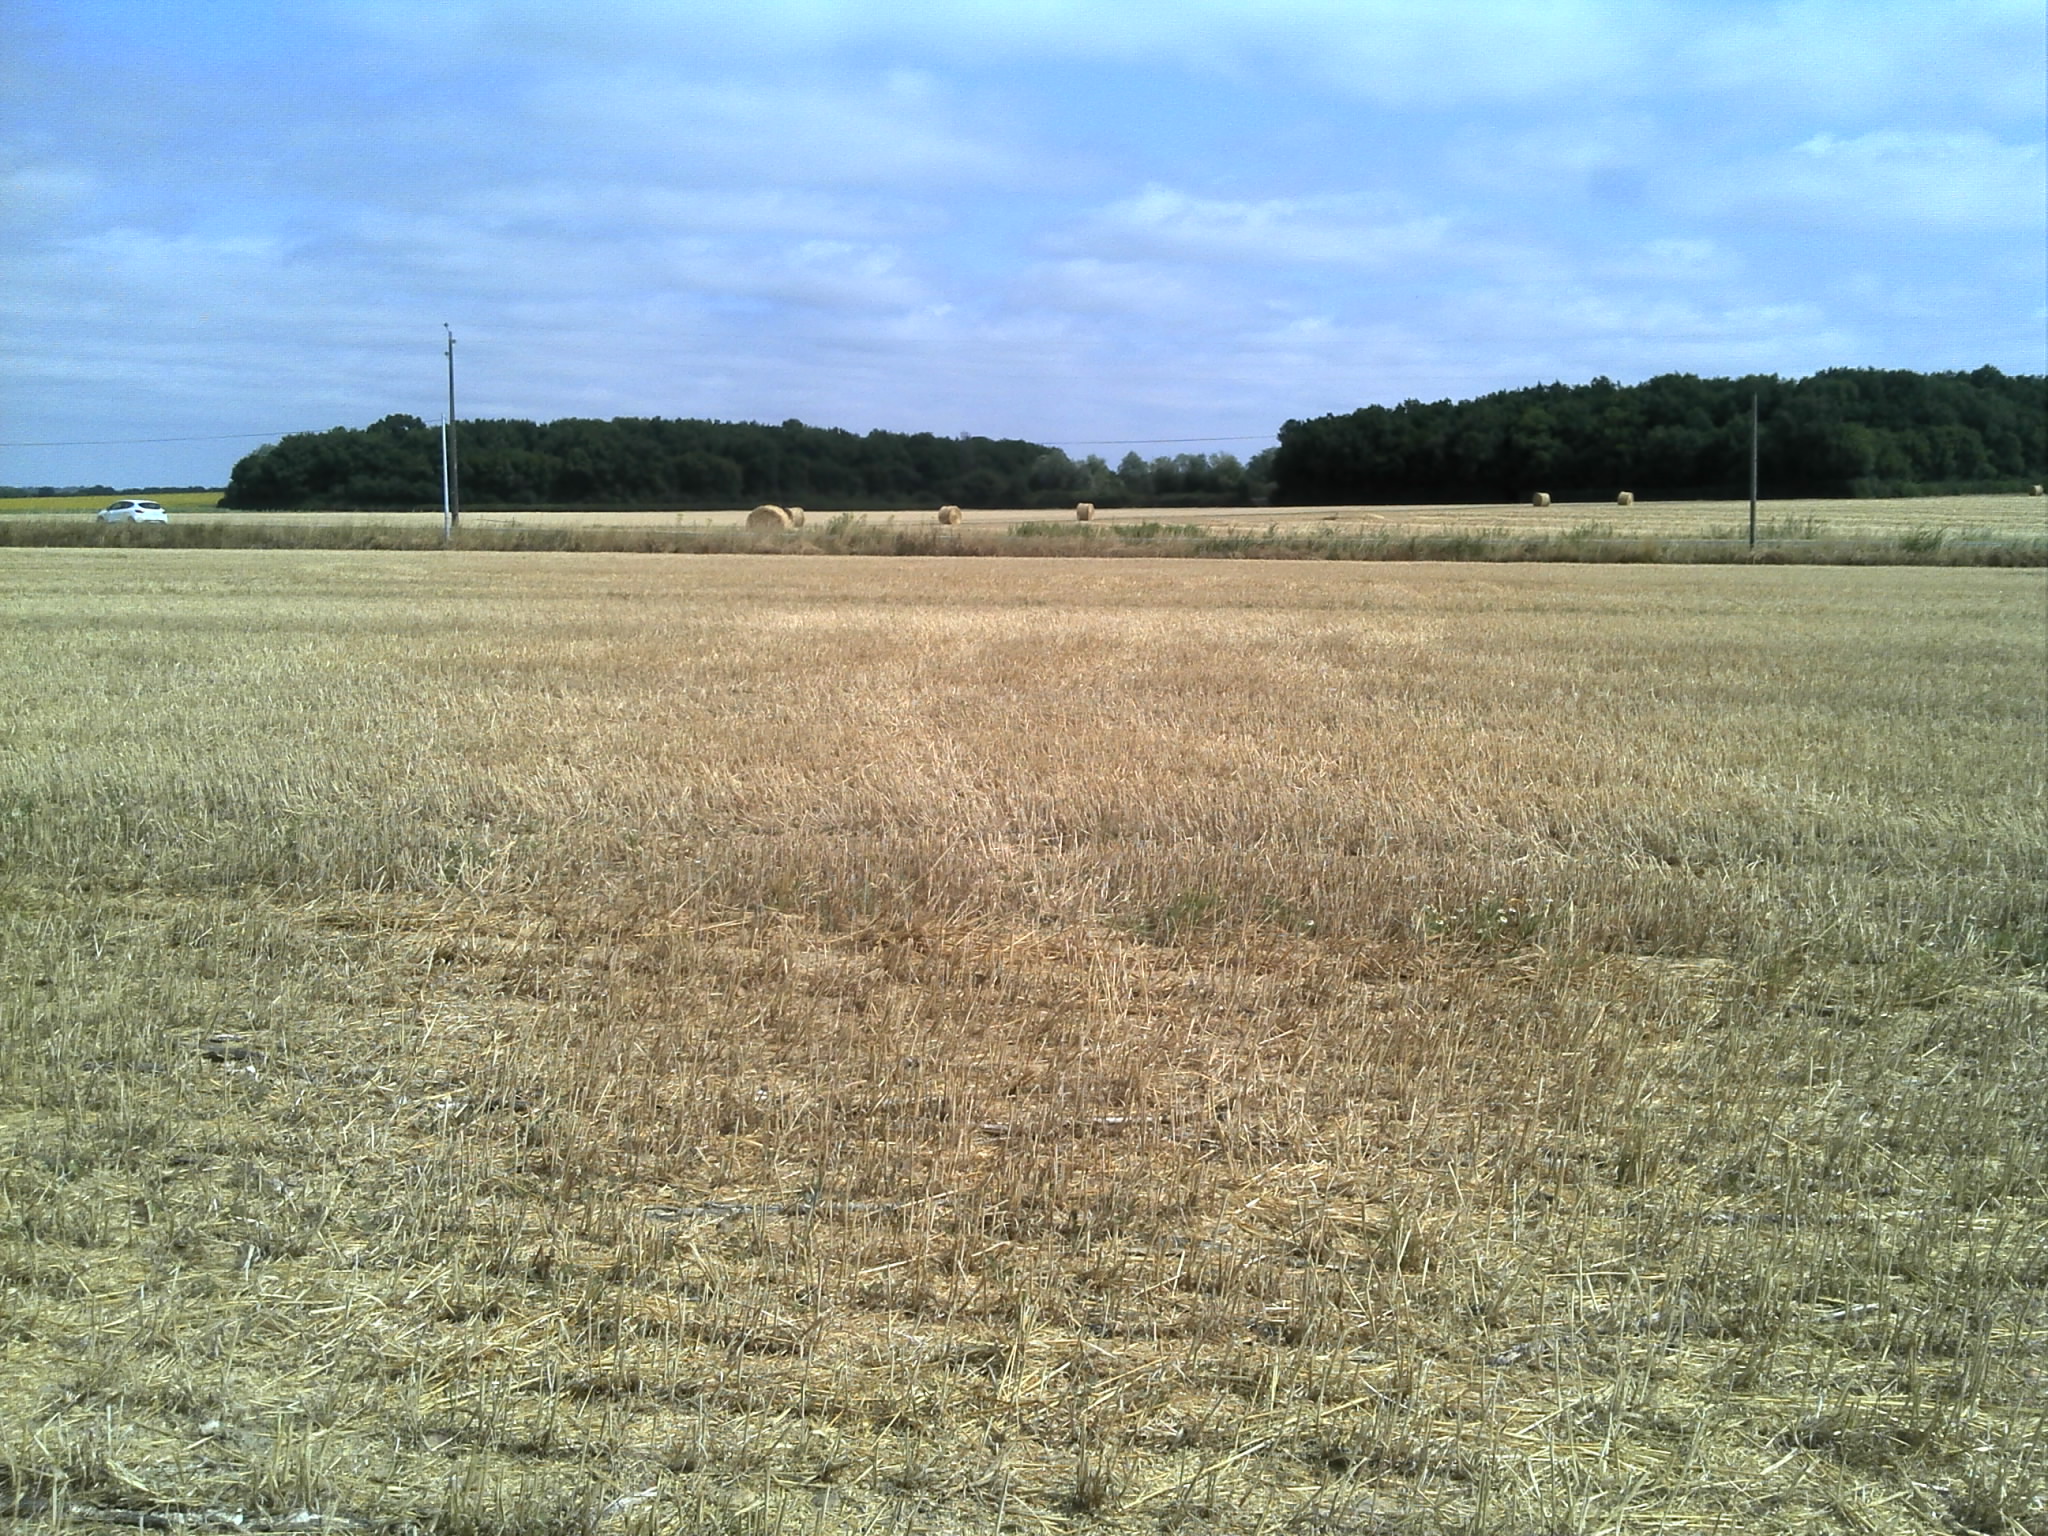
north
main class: Cropland
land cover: Durum wheat
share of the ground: 10 - 25 %
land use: Agriculture (excluding fallow land and kitchen gardens)
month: July
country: FR
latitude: 46.7940
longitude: 1.5387
